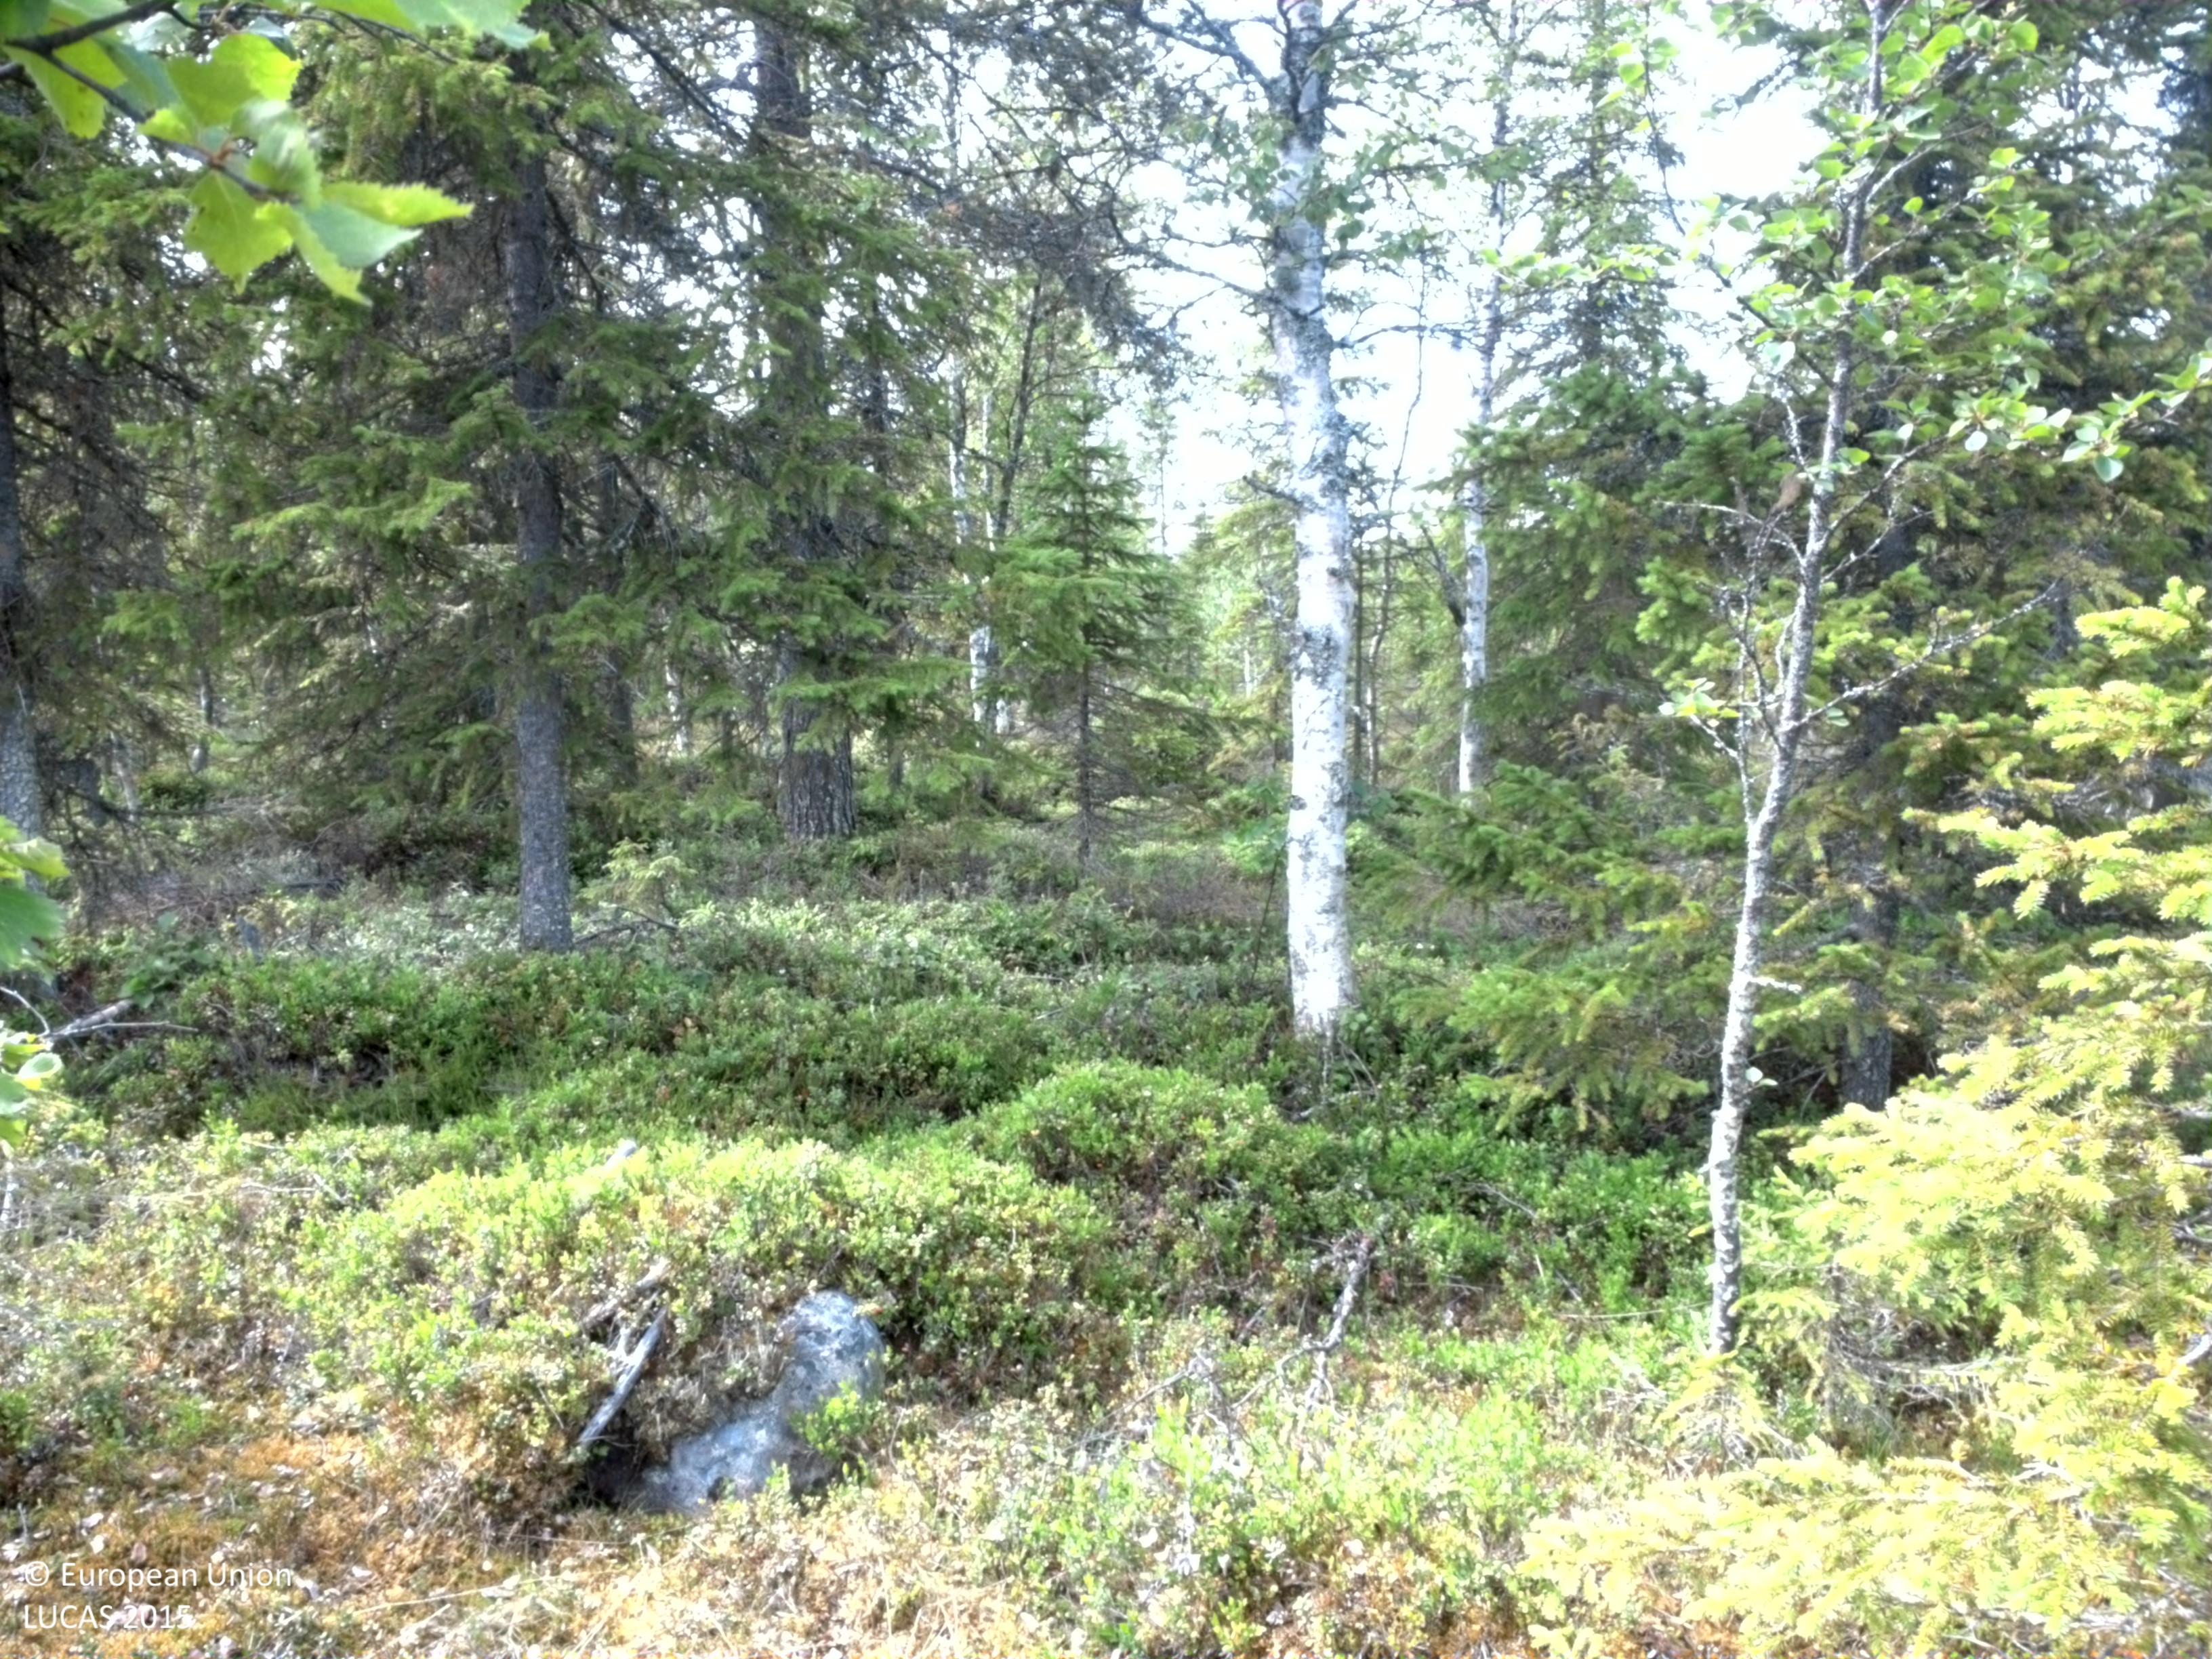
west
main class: Woodland
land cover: Spruce dominated mixed woodland
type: boreal forest
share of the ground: 25 - 50 %
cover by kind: coniferous forest trees 30 %, shrubs 25 %, lichens and mosses 25 %, broadleaved forest trees 10 %, herbaceous plants 10 %
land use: Forestry
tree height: < 5 m
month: July
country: SE
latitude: 64.4912
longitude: 18.2719
